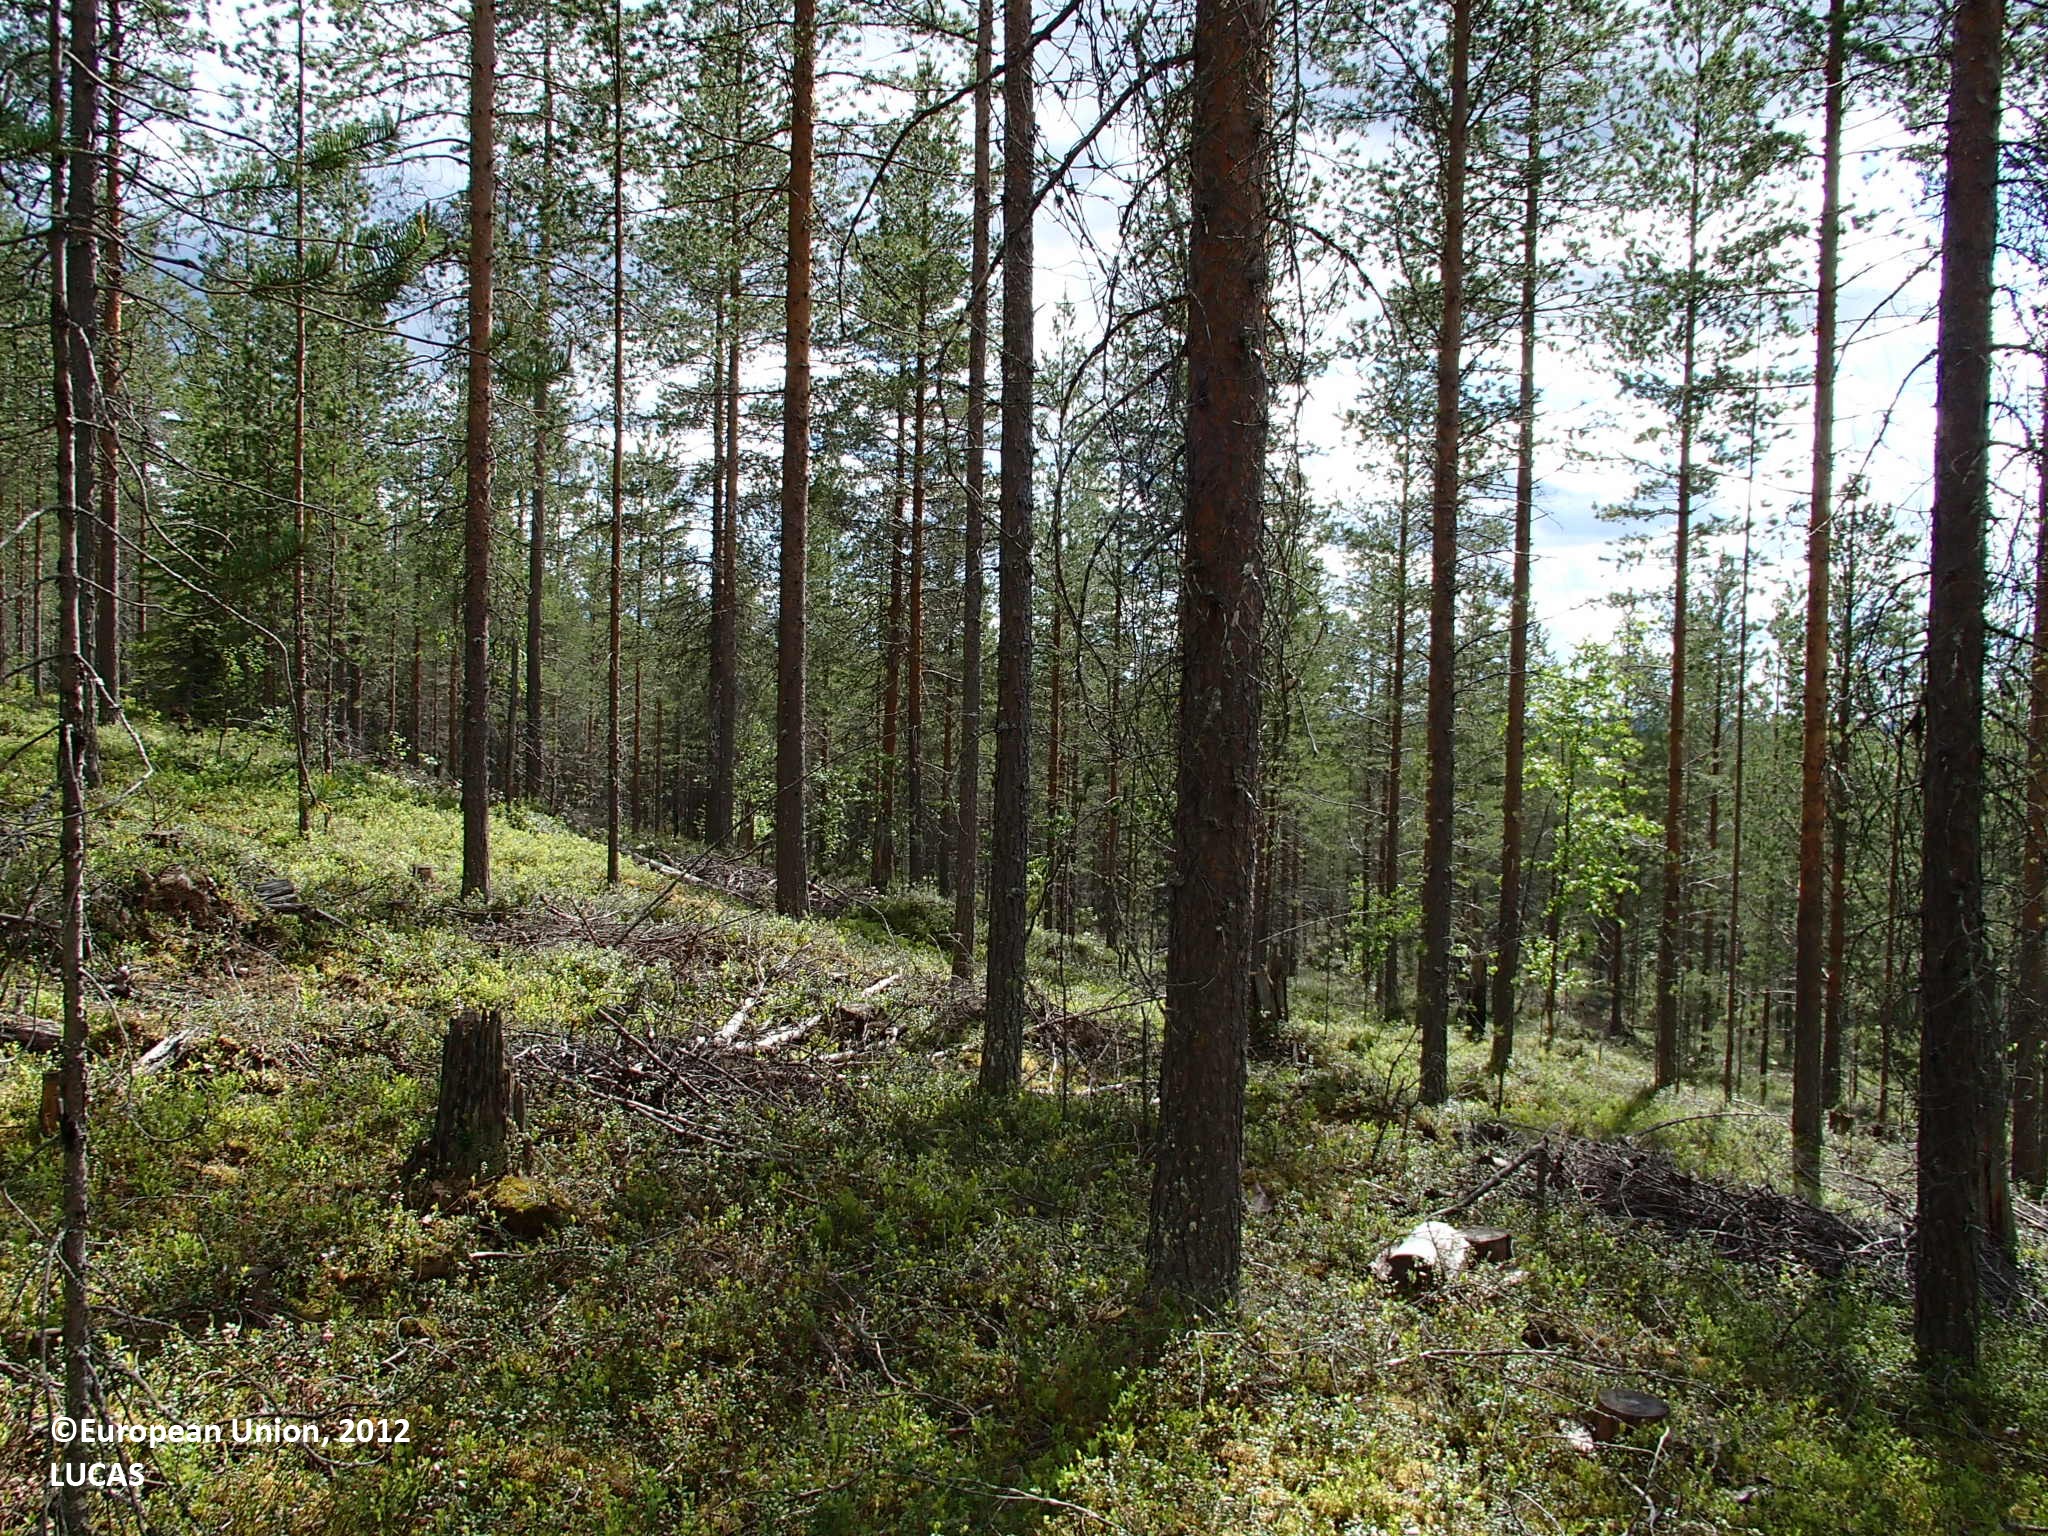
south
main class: Woodland
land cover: Pine dominated coniferous woodland
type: boreal forest
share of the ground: 50 - 75 %
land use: Forestry
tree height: > 5 m
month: June
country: FI
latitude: 66.5696
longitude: 27.2567
